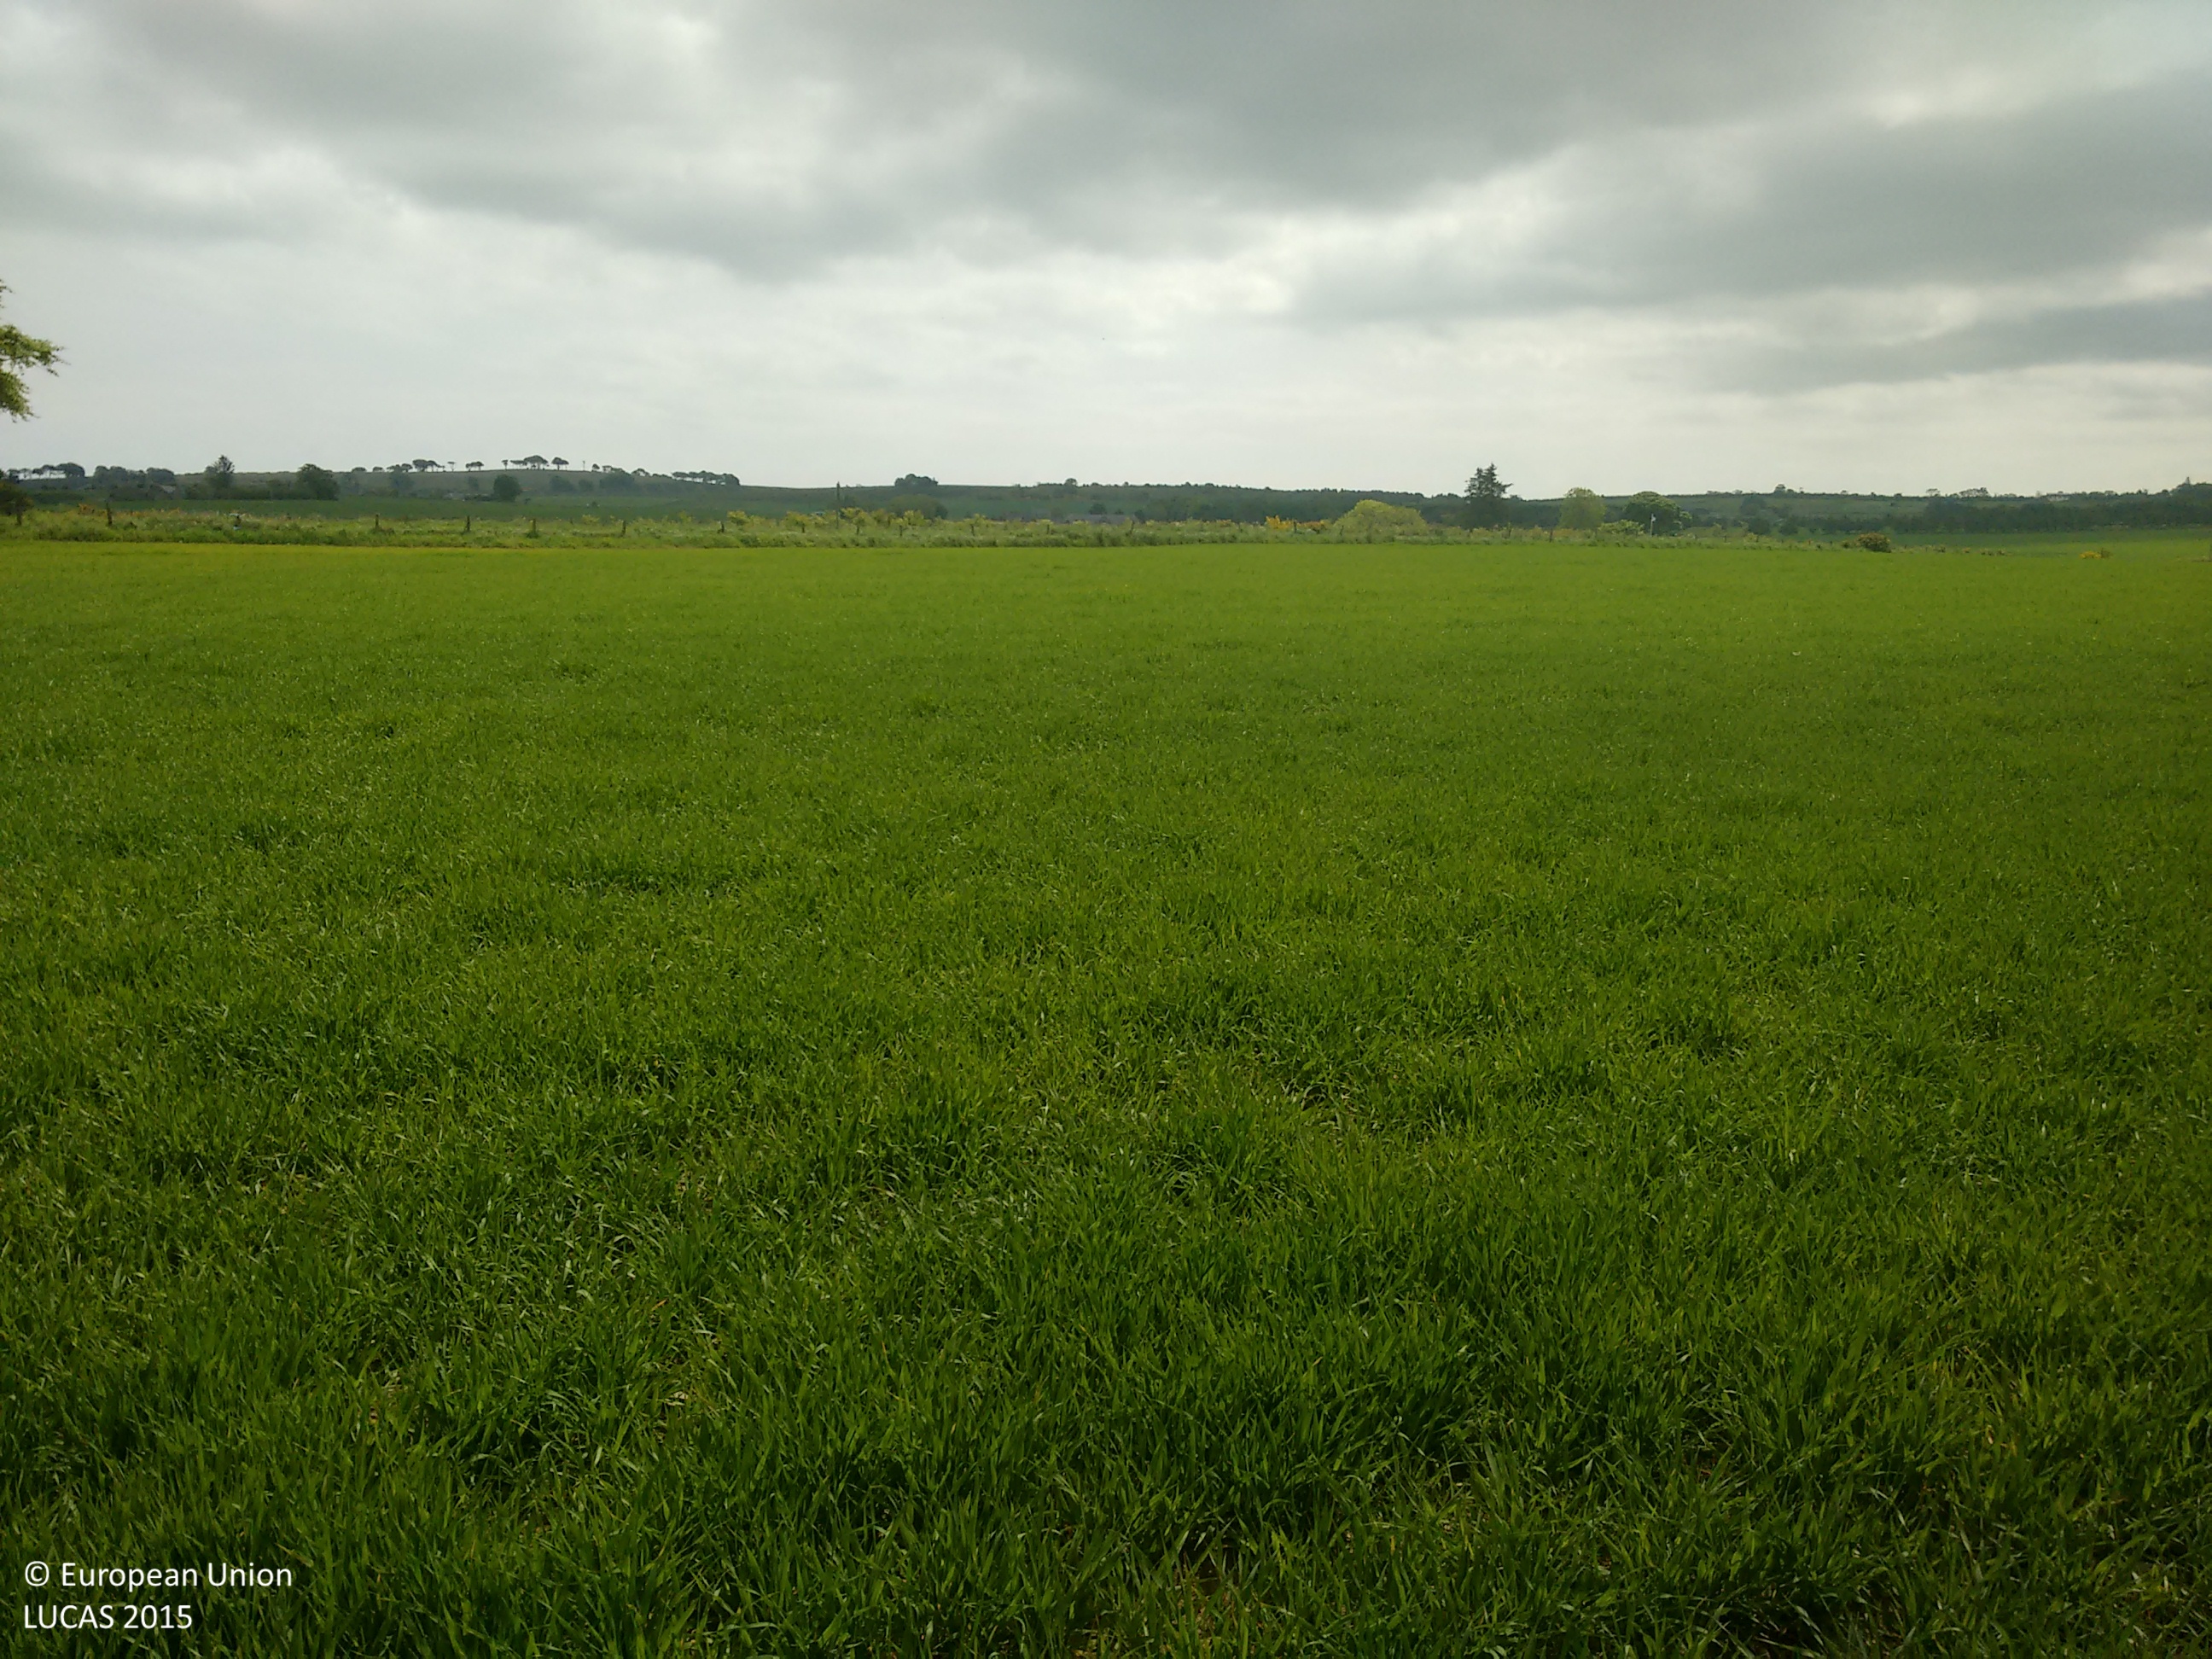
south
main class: Cropland
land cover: Barley
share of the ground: 50 - 75 %
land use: Agriculture (excluding fallow land and kitchen gardens)
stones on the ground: < 10 %
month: June
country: GB
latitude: 57.3132
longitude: -2.2188
